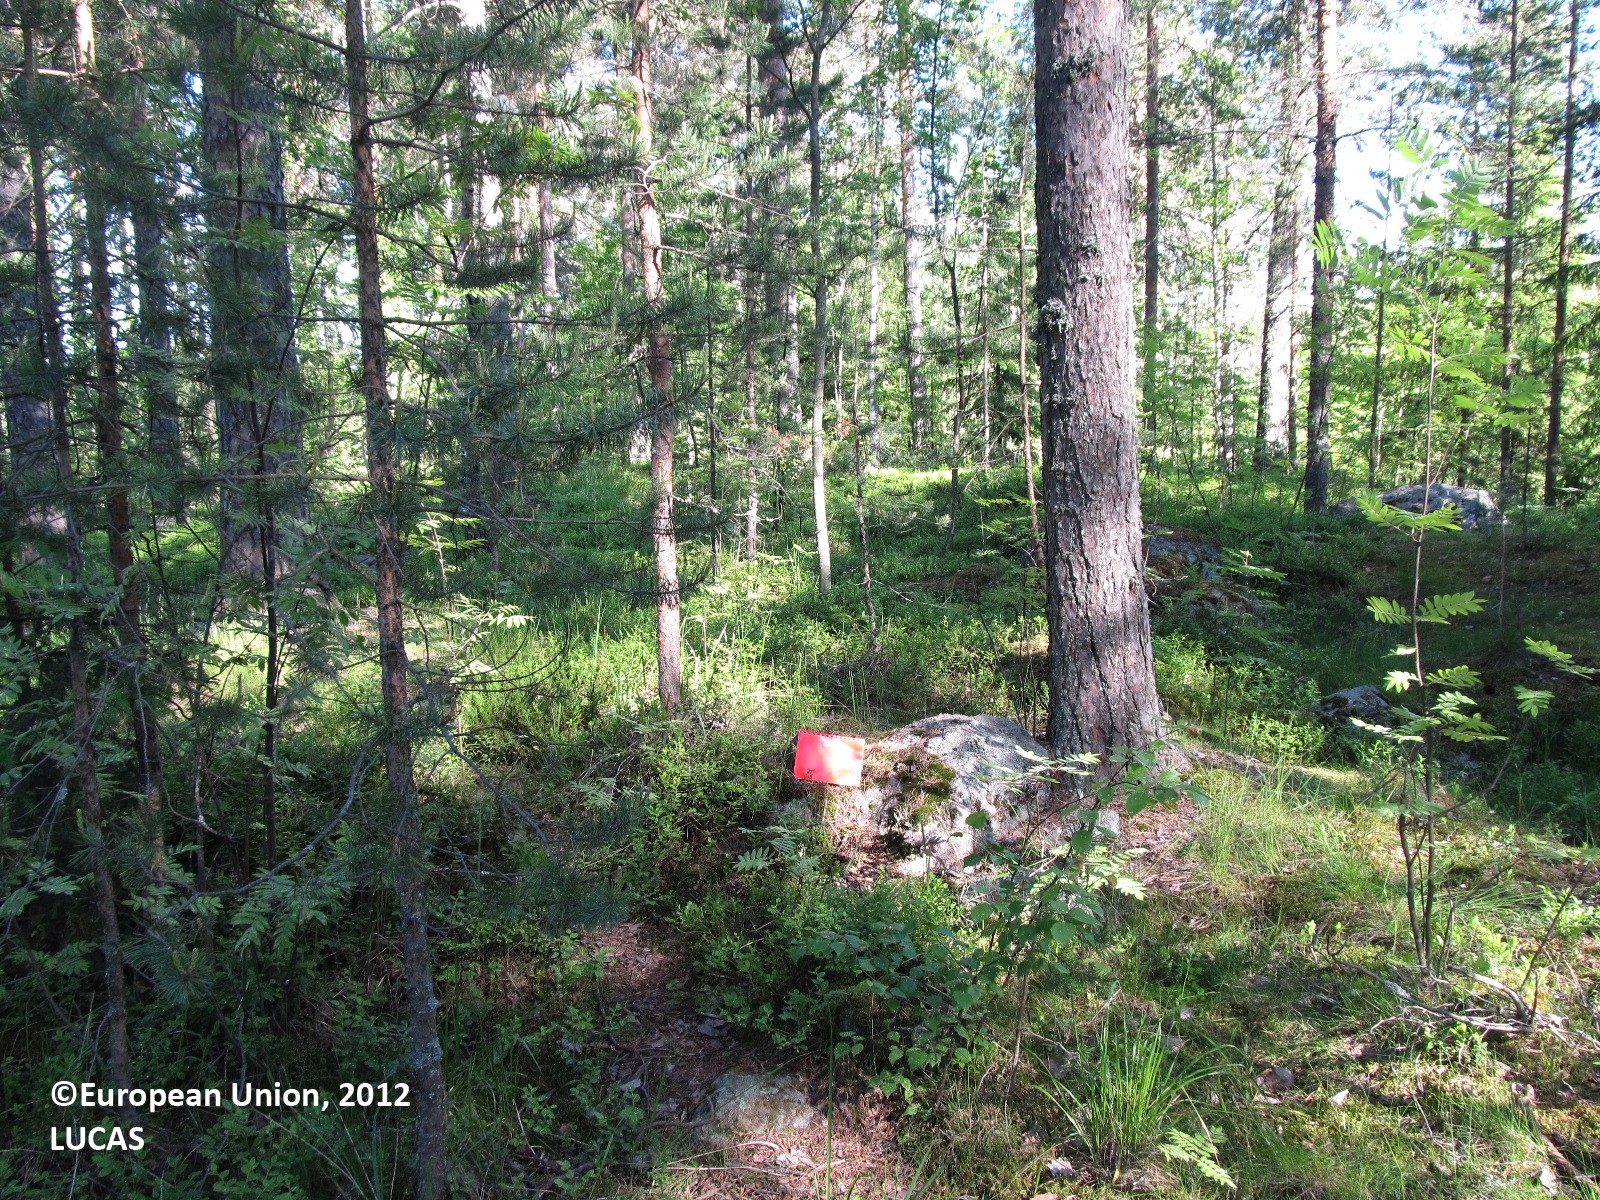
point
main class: Woodland
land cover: Pine dominated coniferous woodland
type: boreal forest
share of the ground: 25 - 50 %
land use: Sport
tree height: > 5 m
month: June
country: FI
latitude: 62.8755
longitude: 27.6455
